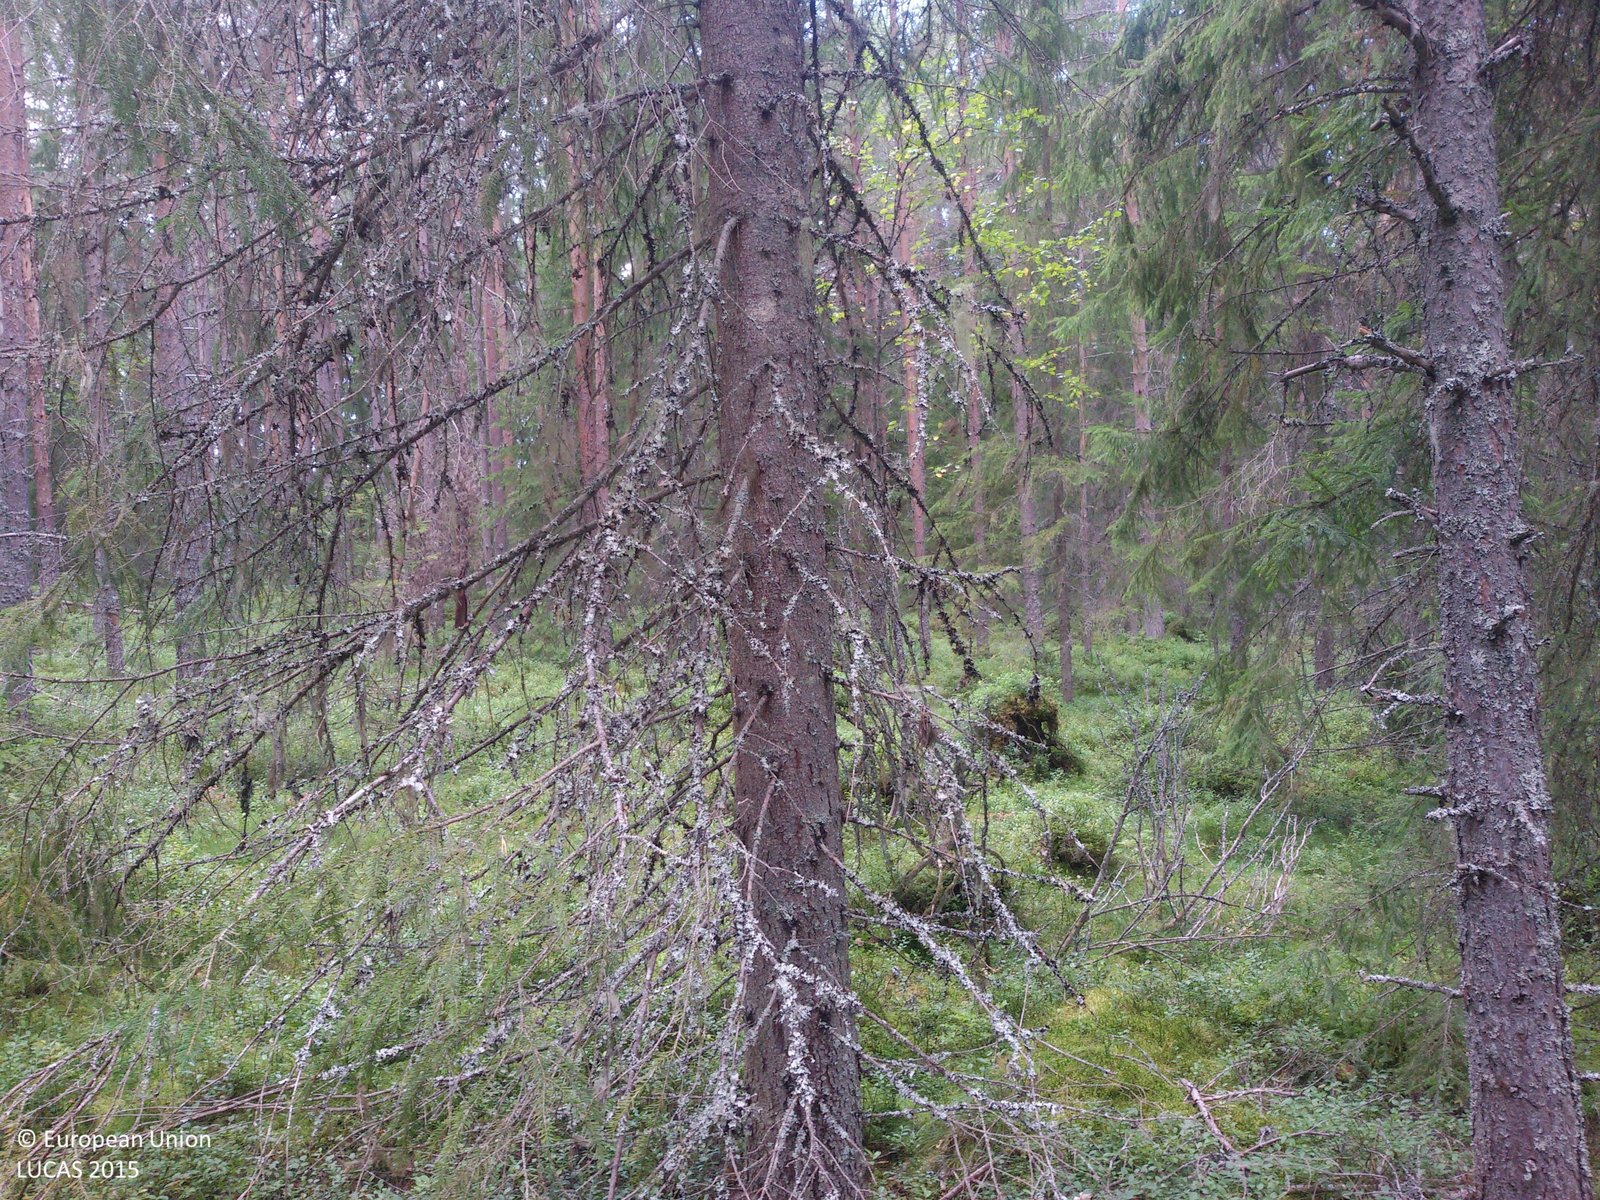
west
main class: Woodland
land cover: Pine dominated coniferous woodland
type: boreal forest
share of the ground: 50 - 75 %
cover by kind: coniferous forest trees 60 %, shrubs 20 %, herbaceous plants 10 %, lichens and mosses 10 %
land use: Forestry
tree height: > 5 m
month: August
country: SE
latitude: 60.7977
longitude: 15.4438
